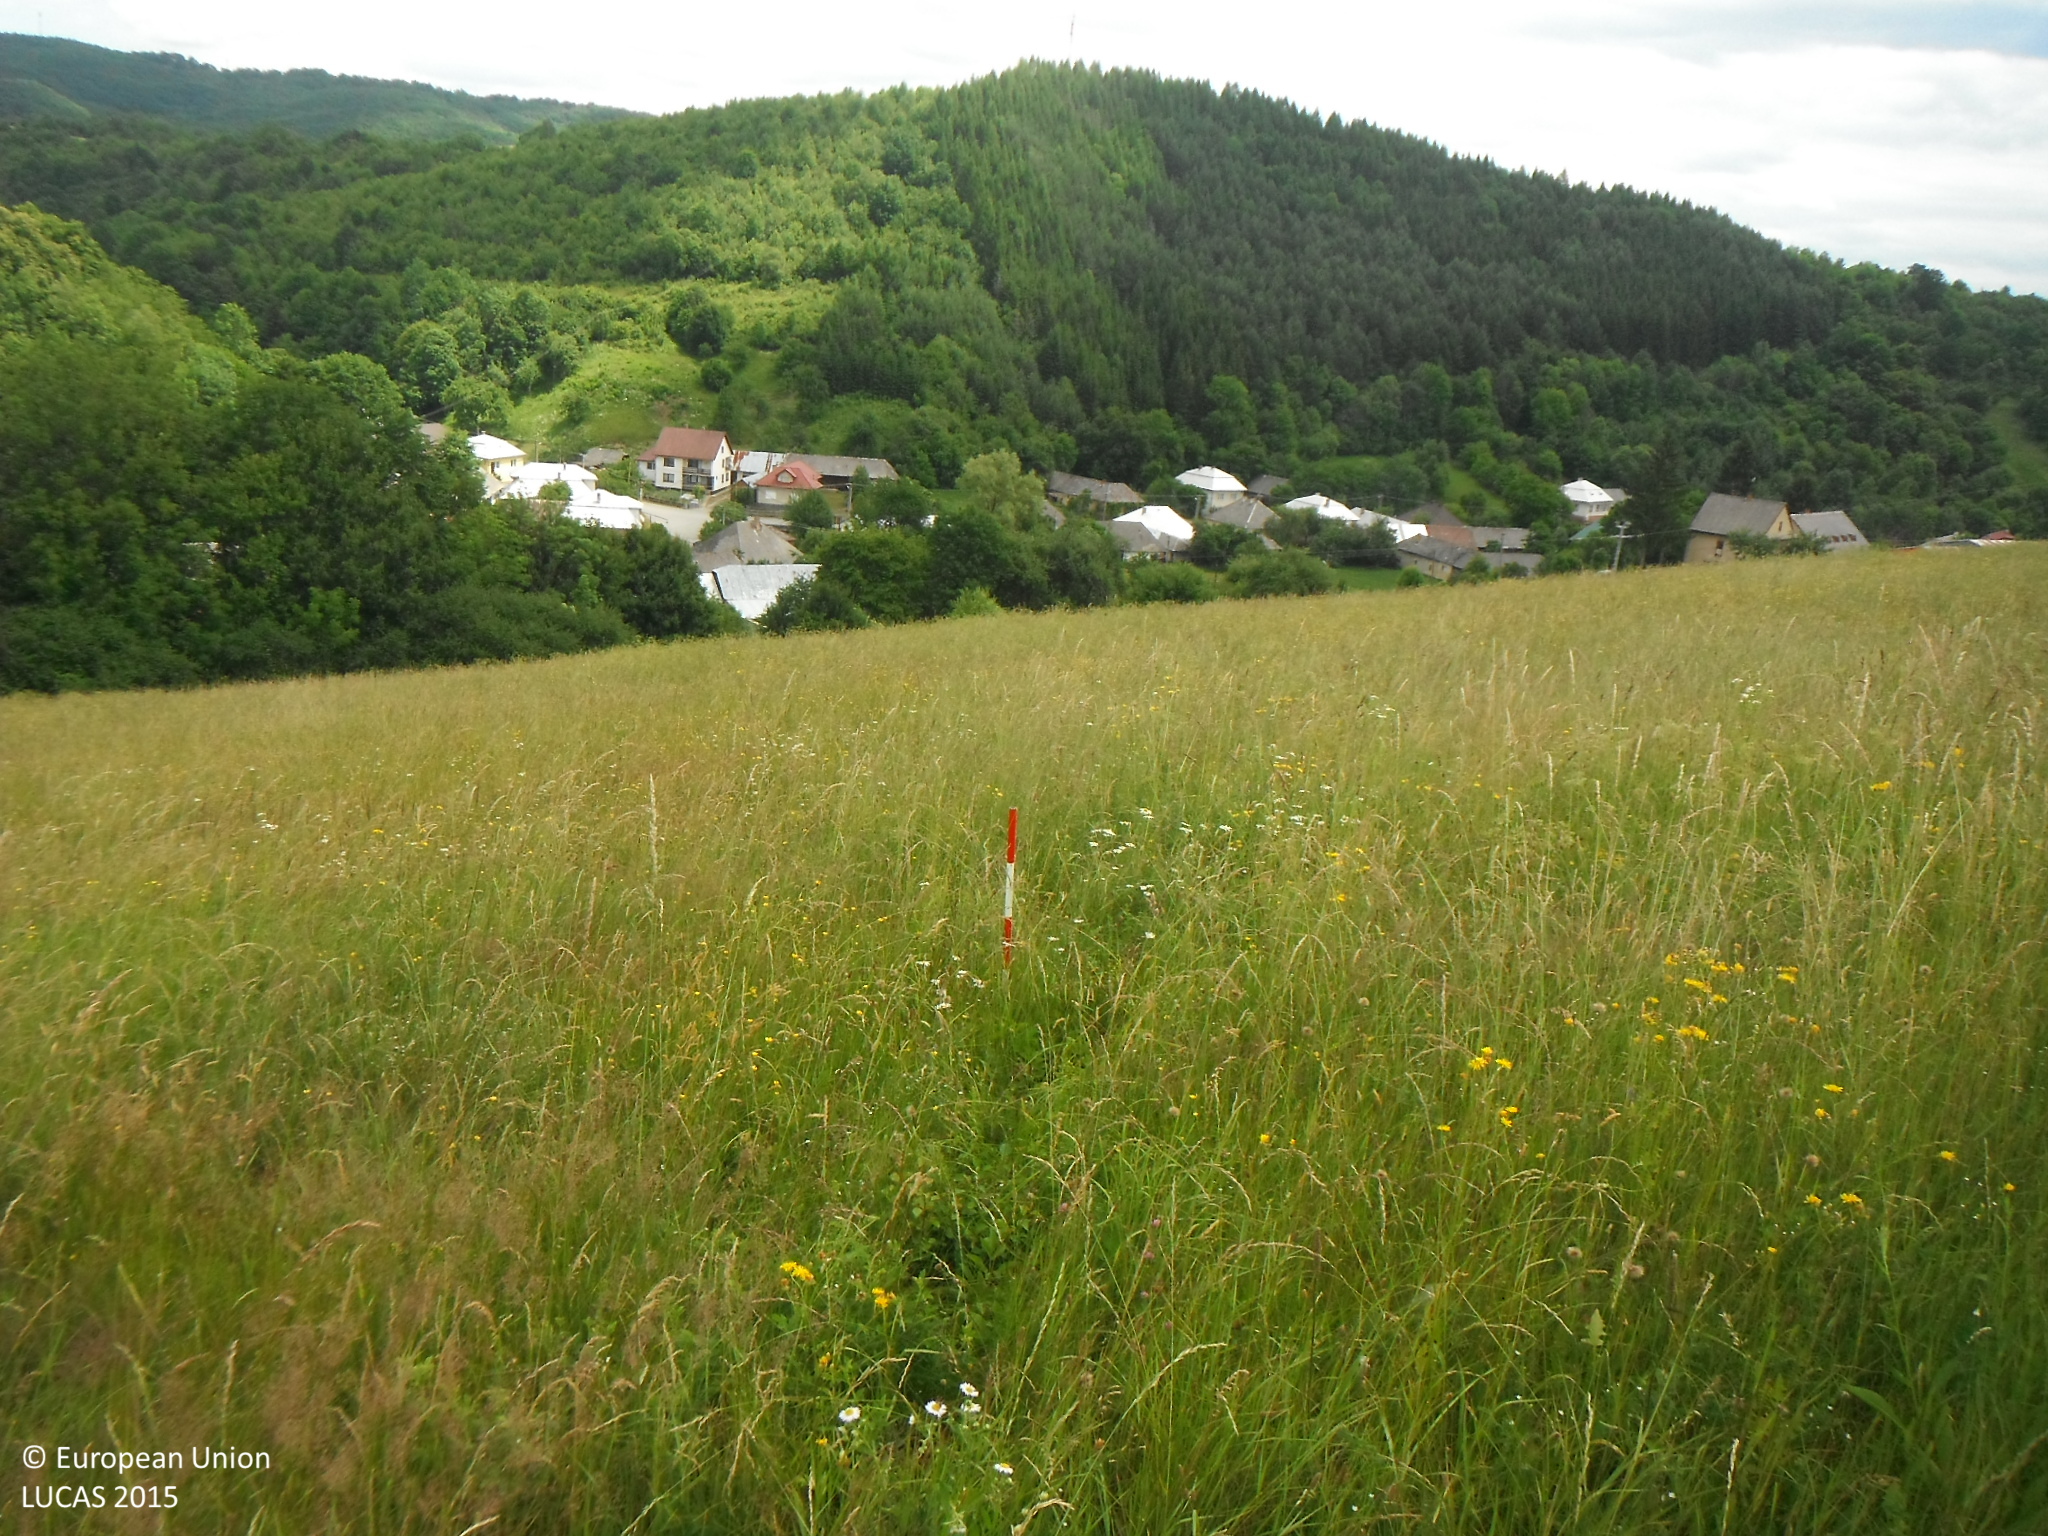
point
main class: Grassland
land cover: Grassland without tree/shrub cover
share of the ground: > 75 %
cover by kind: herbaceous plants 100 %
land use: Agriculture (excluding fallow land and kitchen gardens)
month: June
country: SK
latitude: 48.9442
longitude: 22.3628
